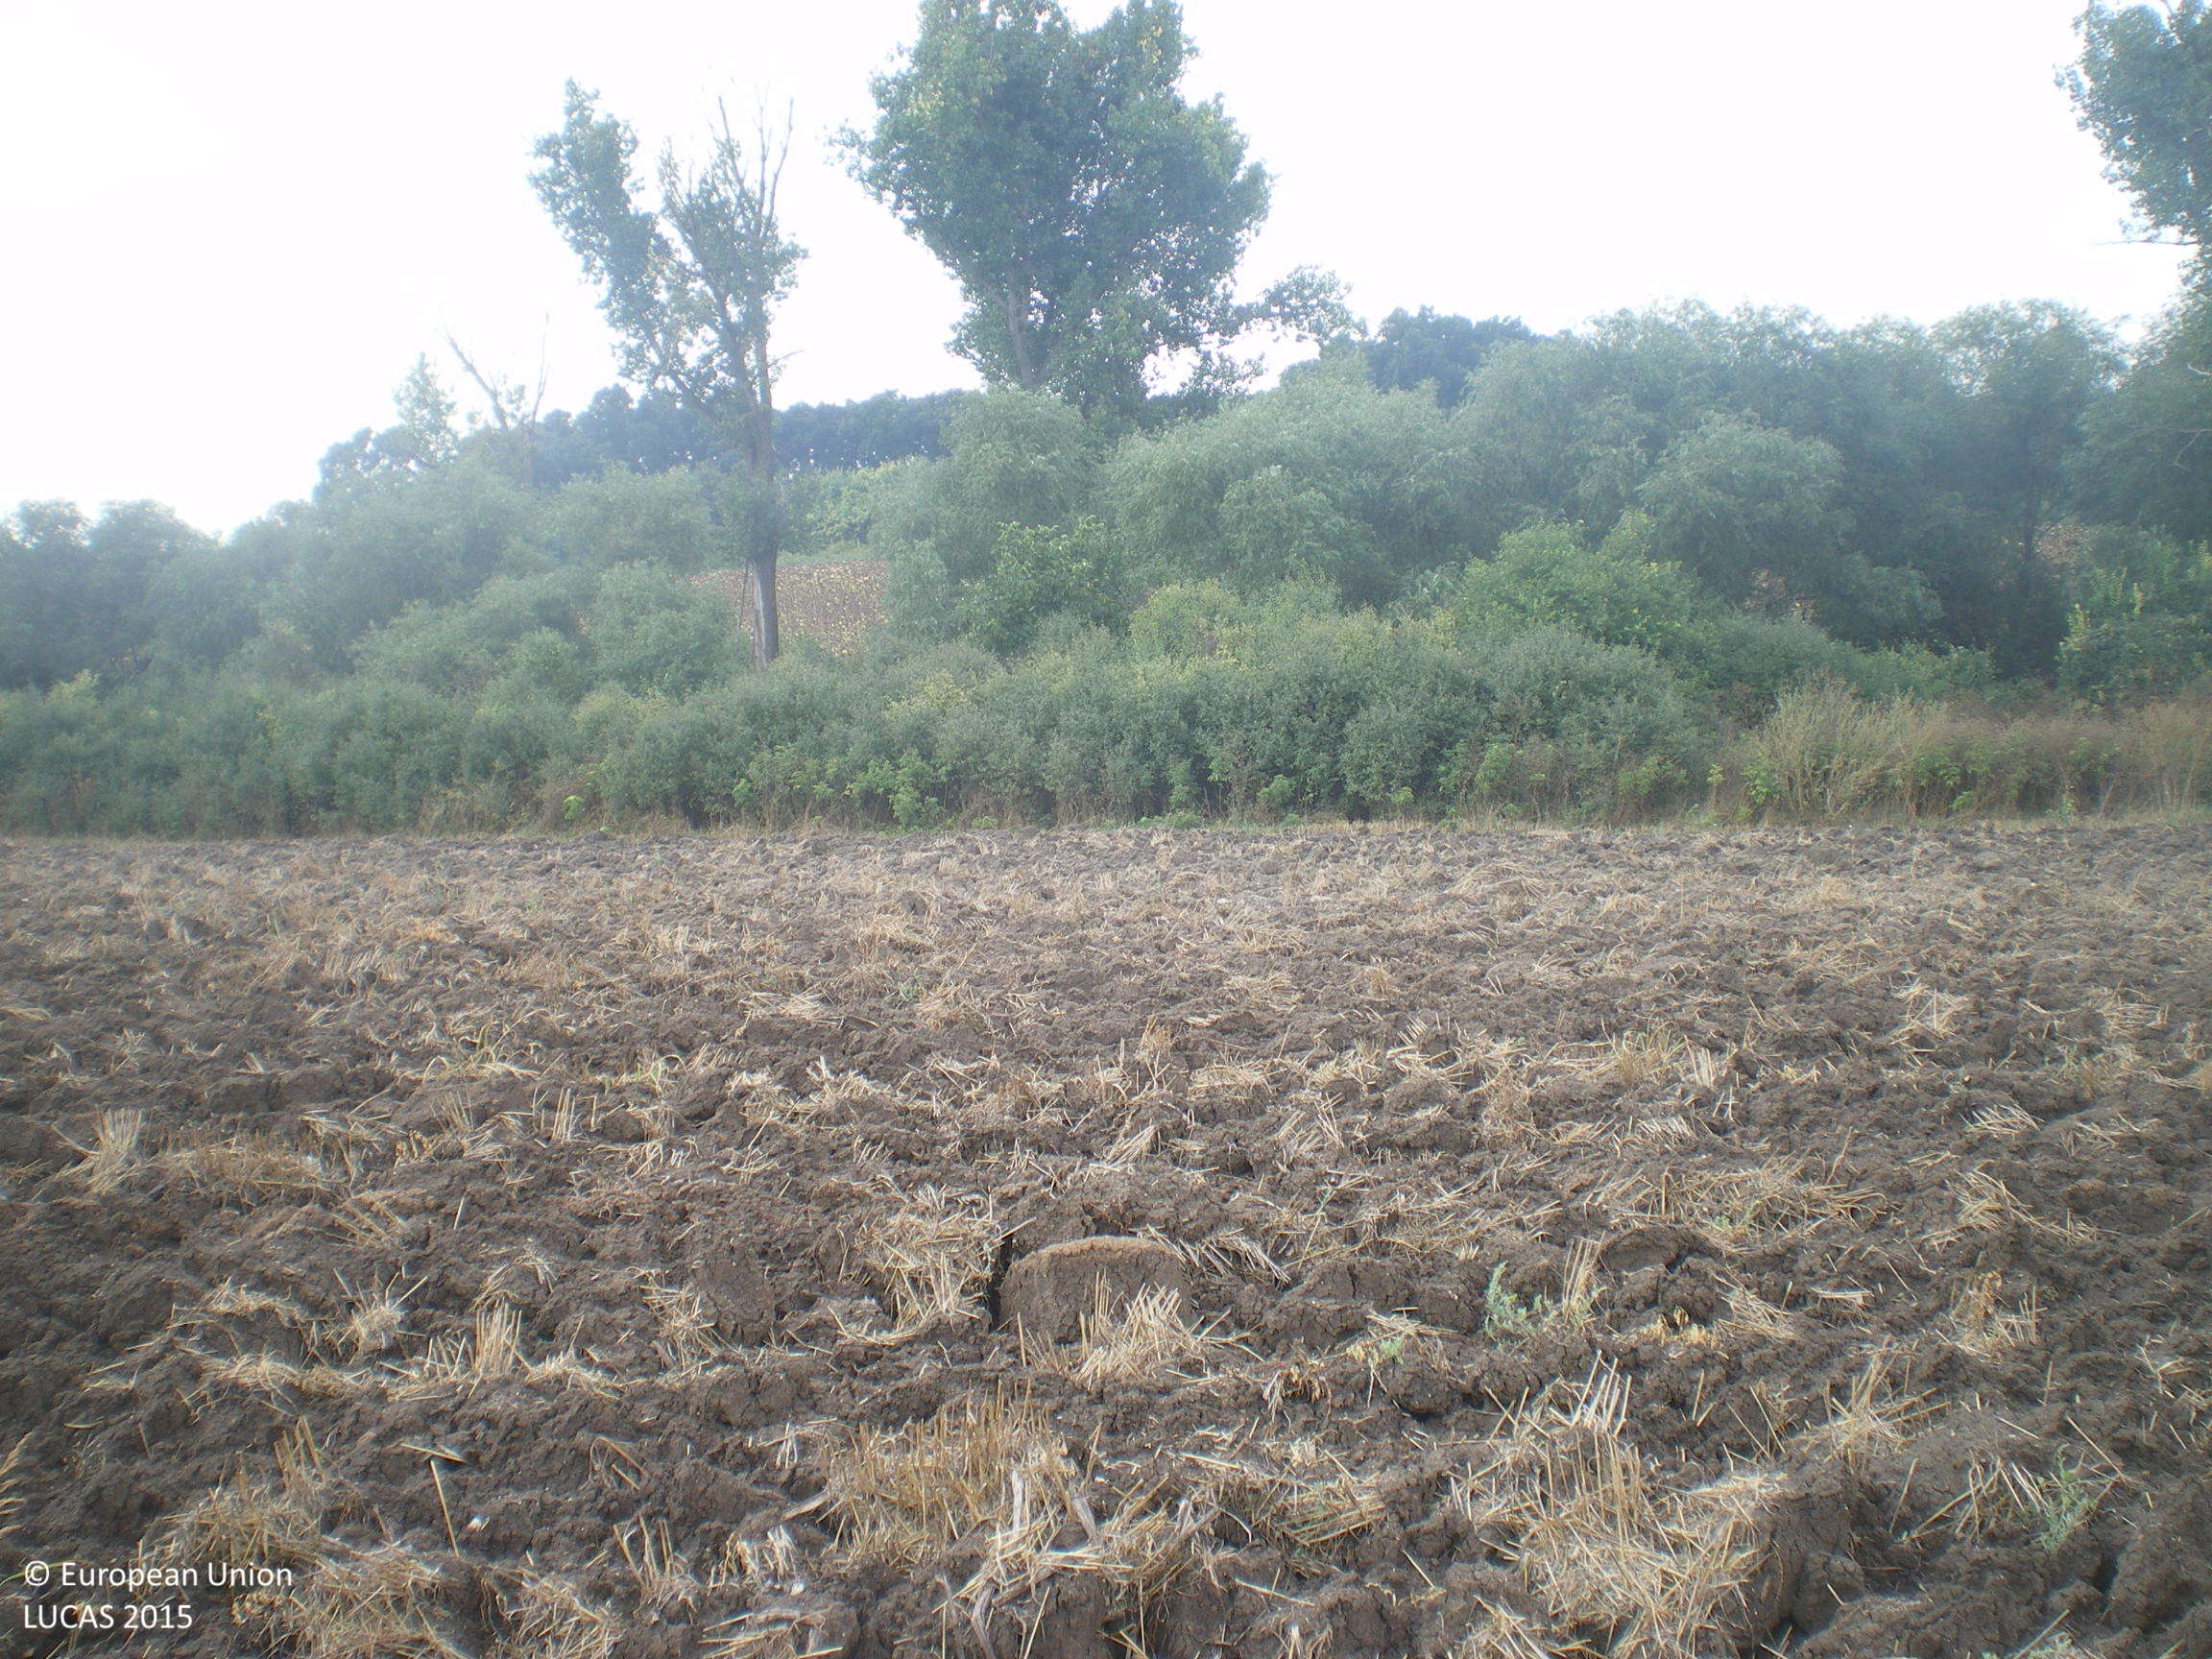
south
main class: Cropland
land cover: Common wheat
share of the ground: < 10 %
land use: Agriculture (excluding fallow land and kitchen gardens)
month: August
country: BG
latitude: 42.3174
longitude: 25.8361
